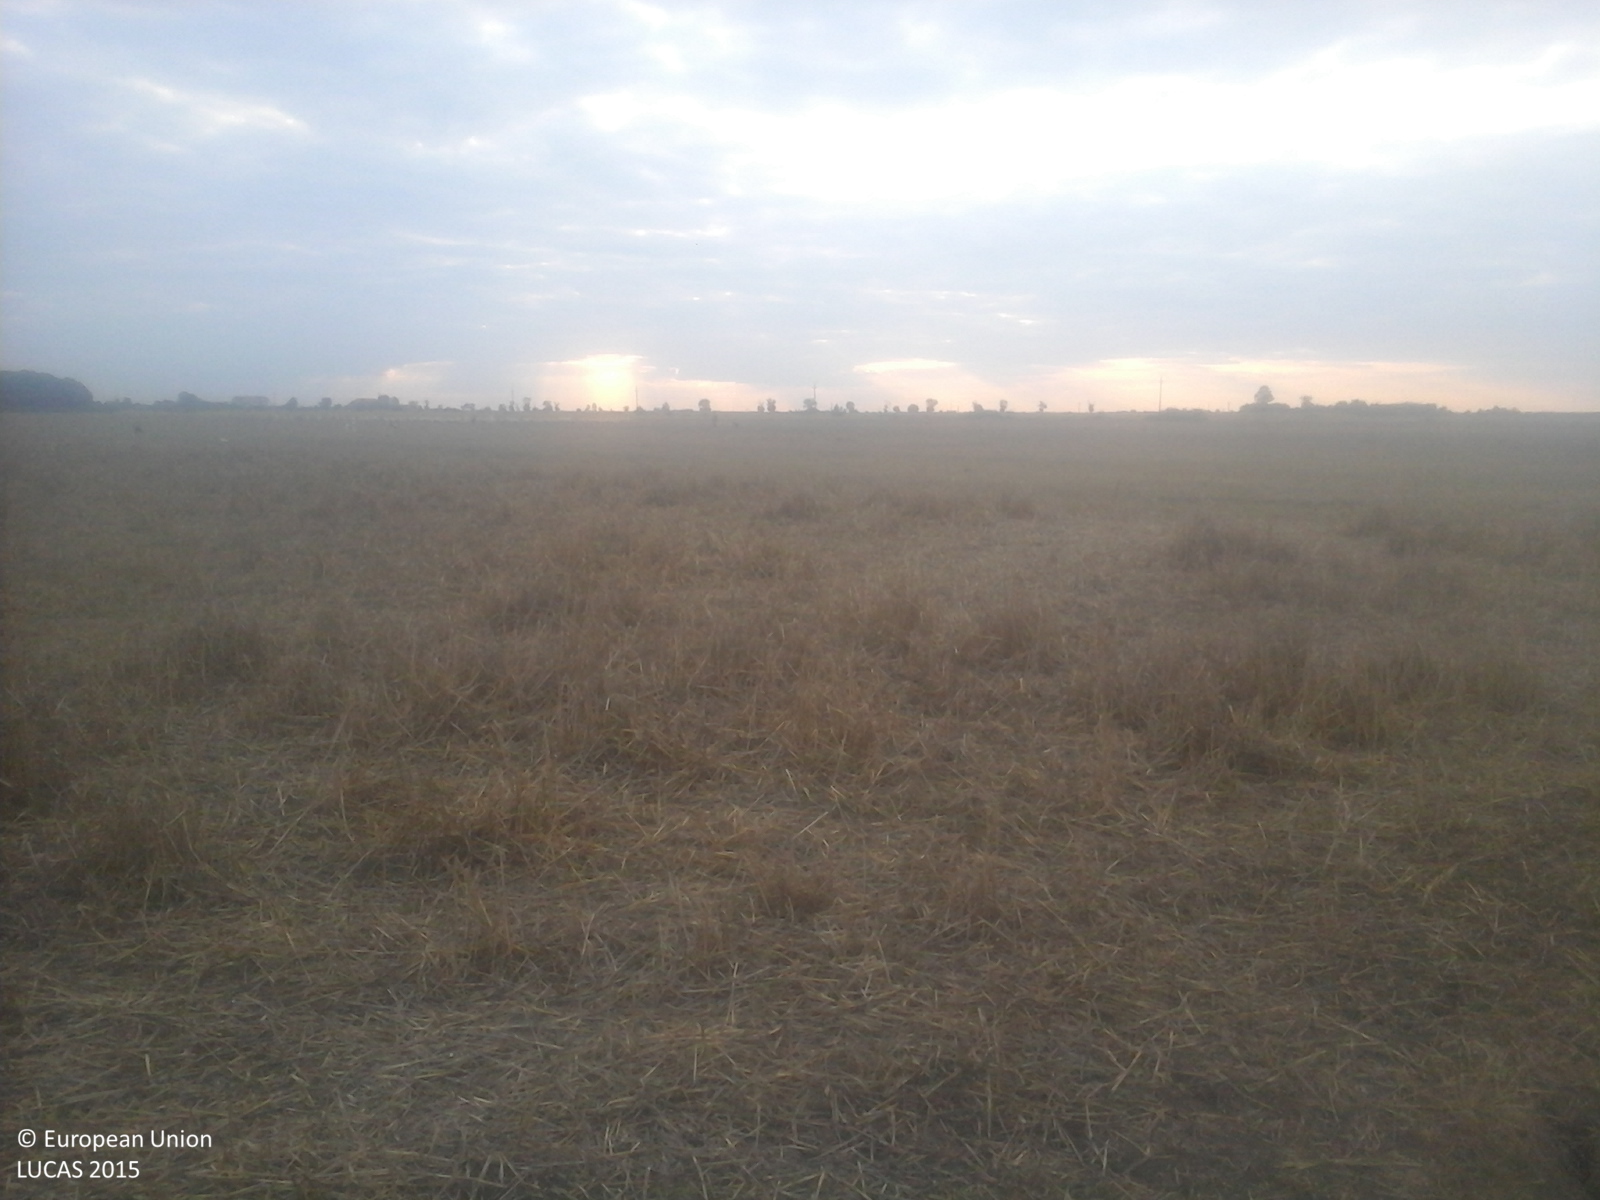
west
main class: Grassland
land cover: Grassland without tree/shrub cover
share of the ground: > 75 %
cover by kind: herbaceous plants 100 %
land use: Agriculture (excluding fallow land and kitchen gardens)
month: September
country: RO
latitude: 47.7531
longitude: 22.7479
